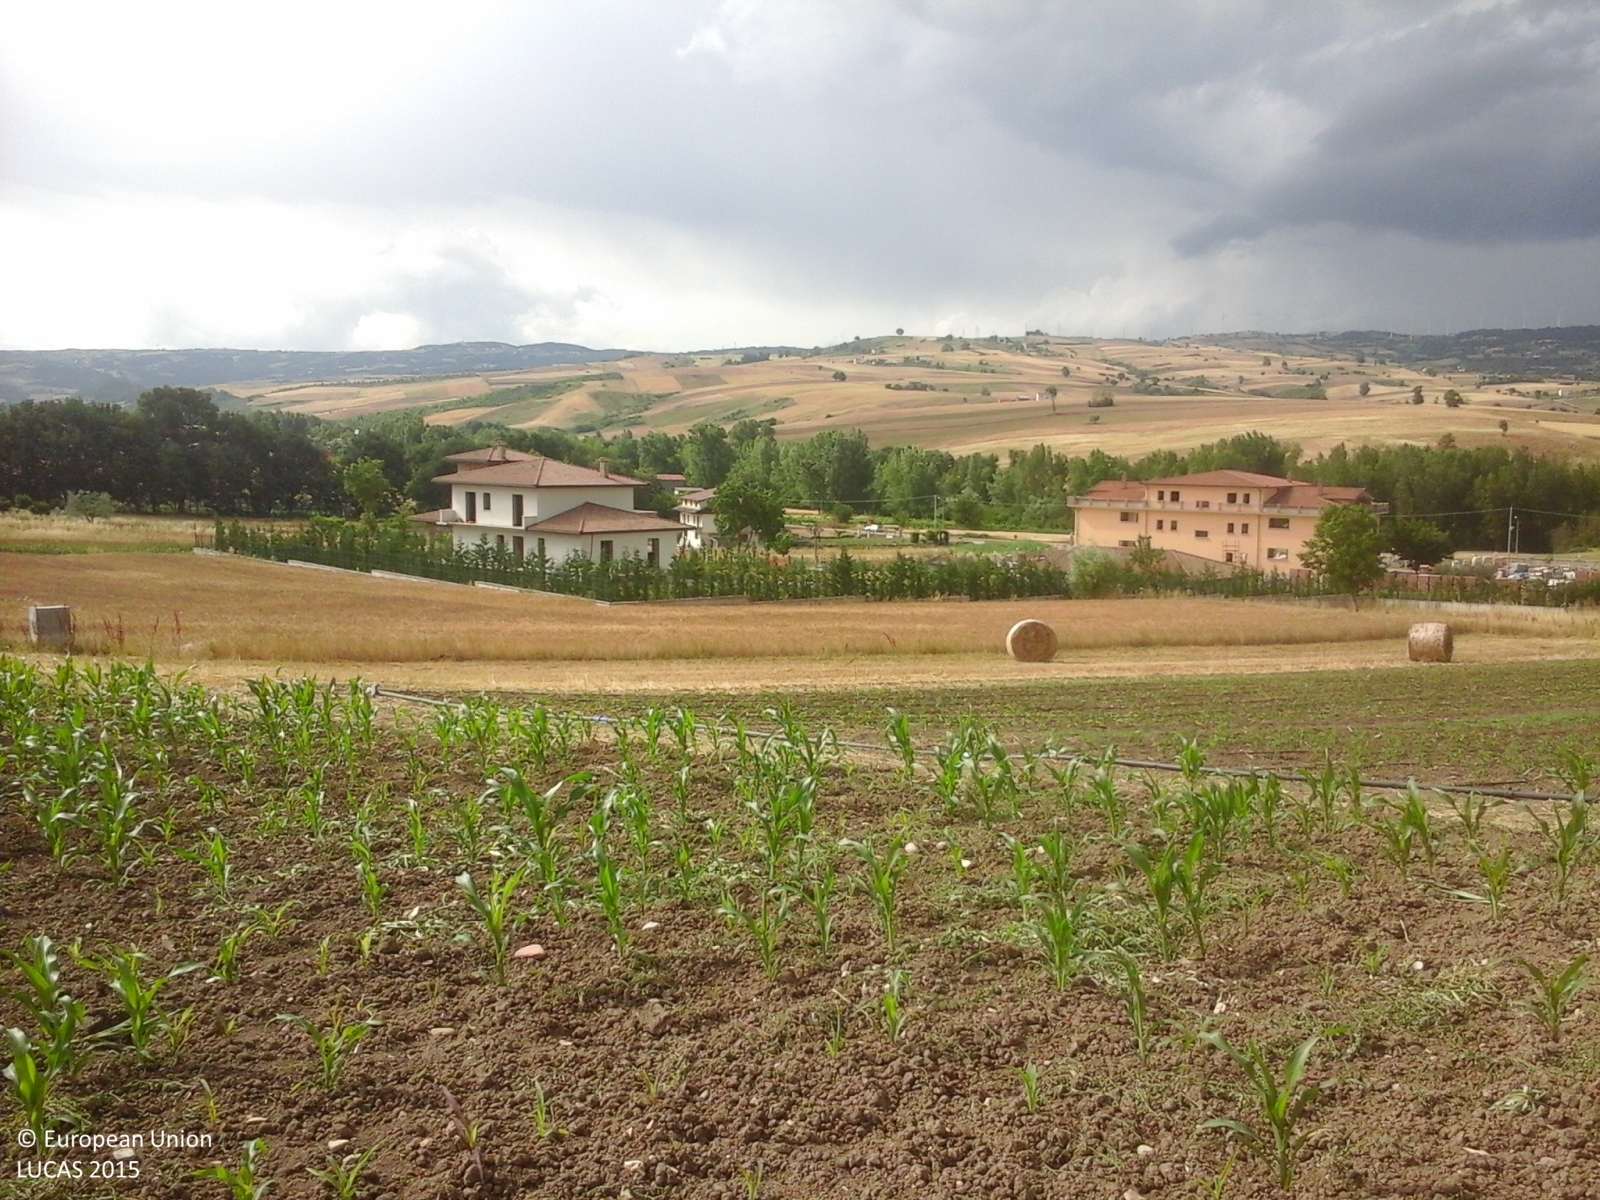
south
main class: Cropland
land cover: Maize
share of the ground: 25 - 50 %
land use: Agriculture (excluding fallow land and kitchen gardens)
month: June
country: IT
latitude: 41.0381
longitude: 15.1552
